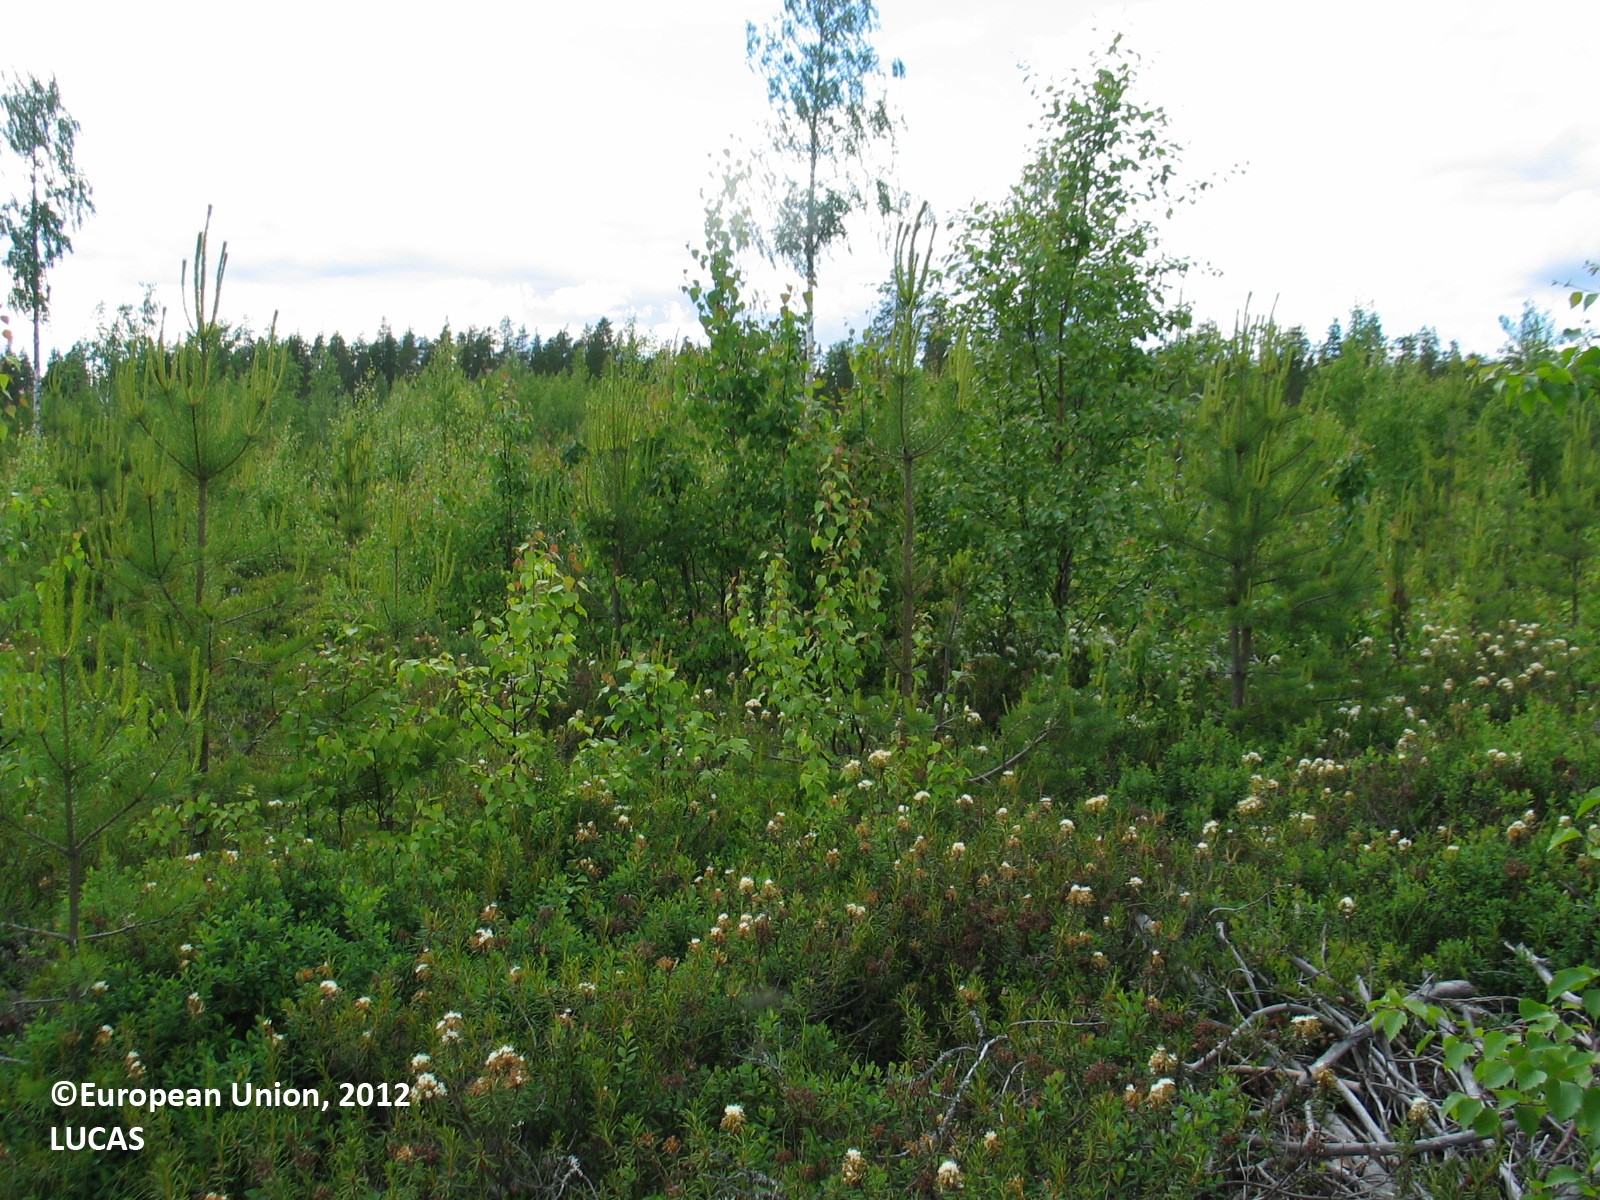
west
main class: Woodland
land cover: Other mixed woodland
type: boreal forest
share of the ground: 25 - 50 %
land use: Forestry
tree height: < 5 m
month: June
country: FI
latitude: 64.8346
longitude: 26.5729
